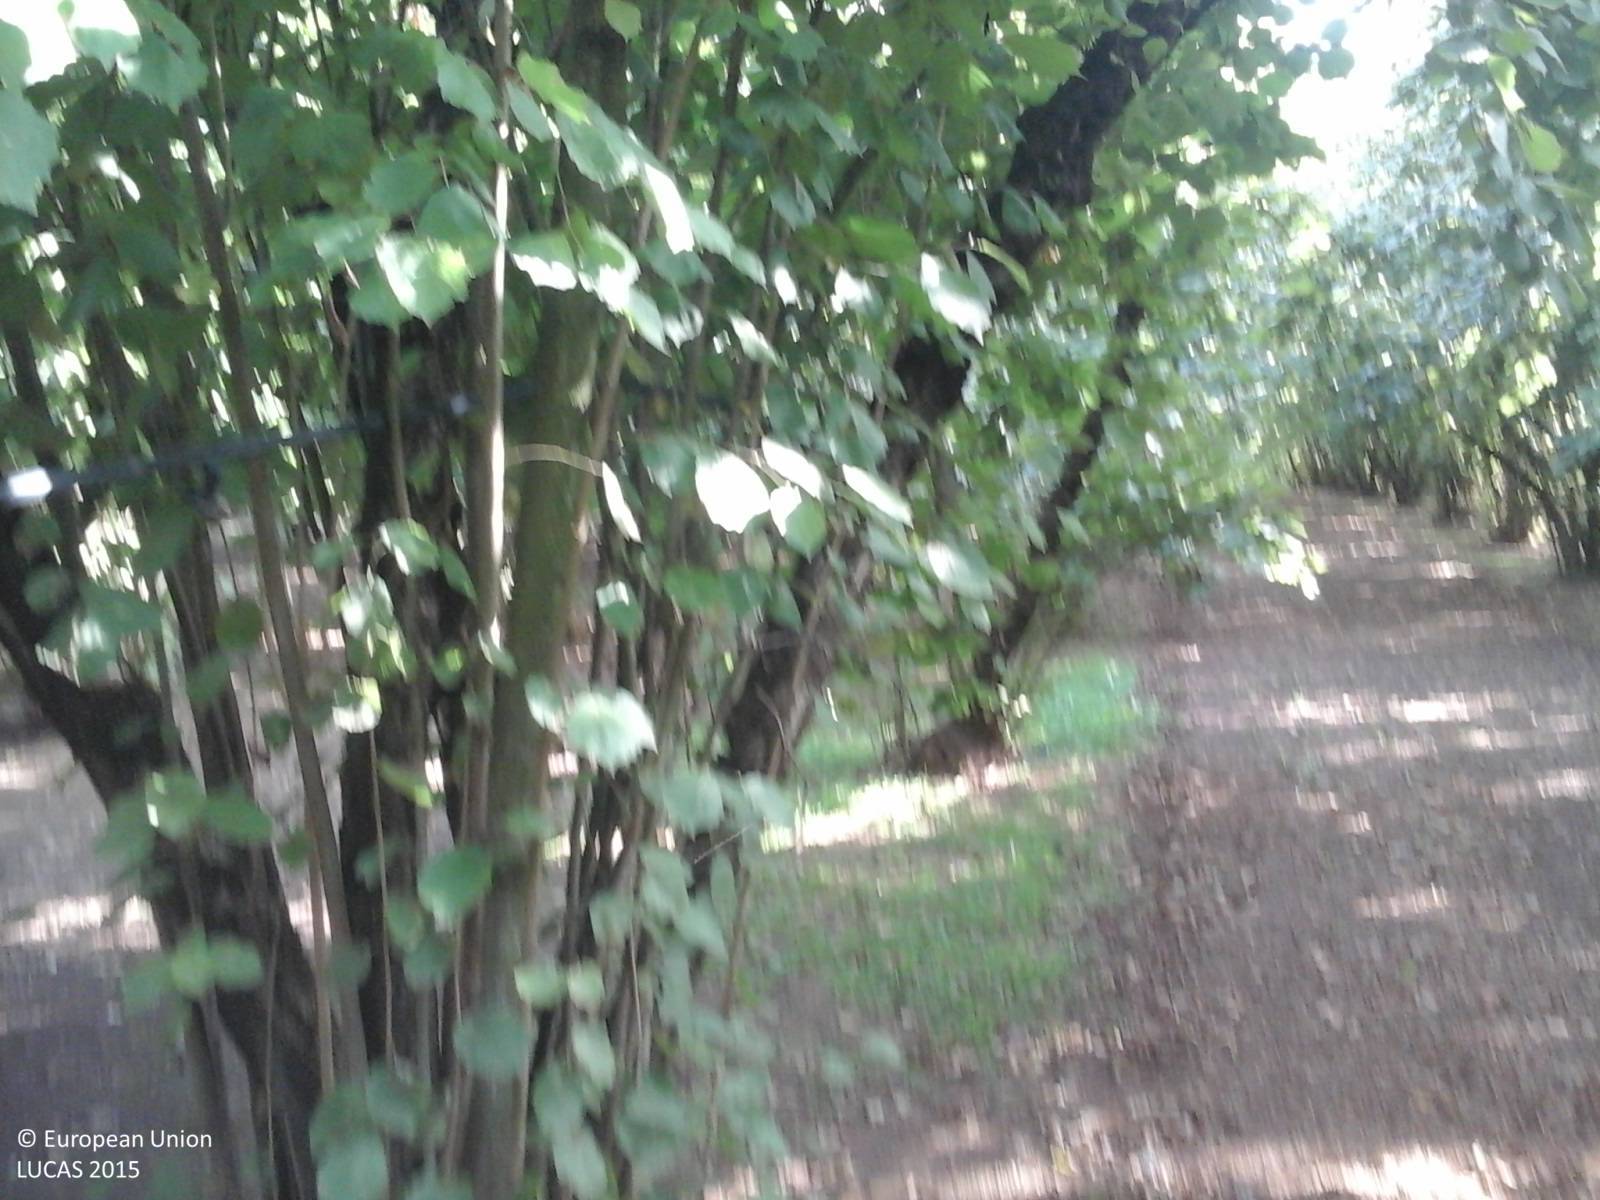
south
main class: Cropland
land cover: Nuts trees
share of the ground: > 75 %
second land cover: Other bare soil
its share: > 75 %
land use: Agriculture (excluding fallow land and kitchen gardens)
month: September
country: IT
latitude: 42.3544
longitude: 12.4077
